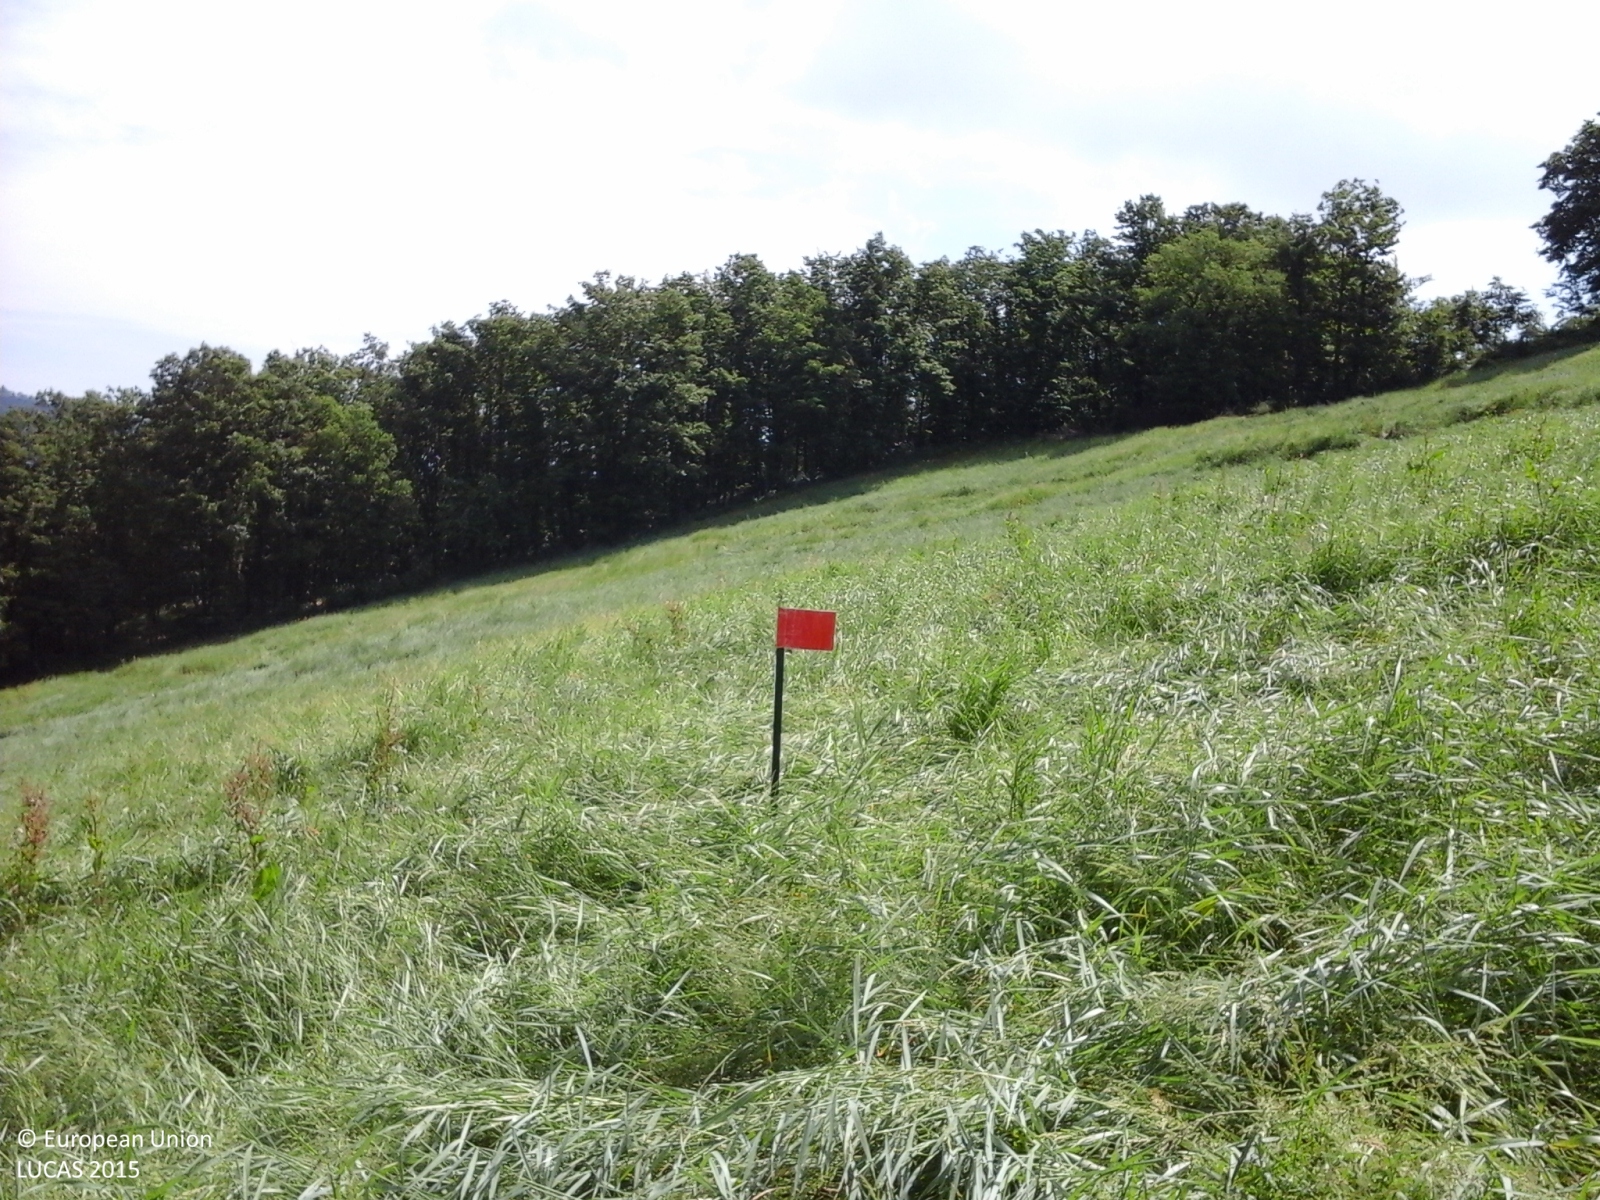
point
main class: Cropland
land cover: Lucerne
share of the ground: > 75 %
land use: Agriculture (excluding fallow land and kitchen gardens)
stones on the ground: < 10 %
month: May
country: IT
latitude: 44.4020
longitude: 10.7391
